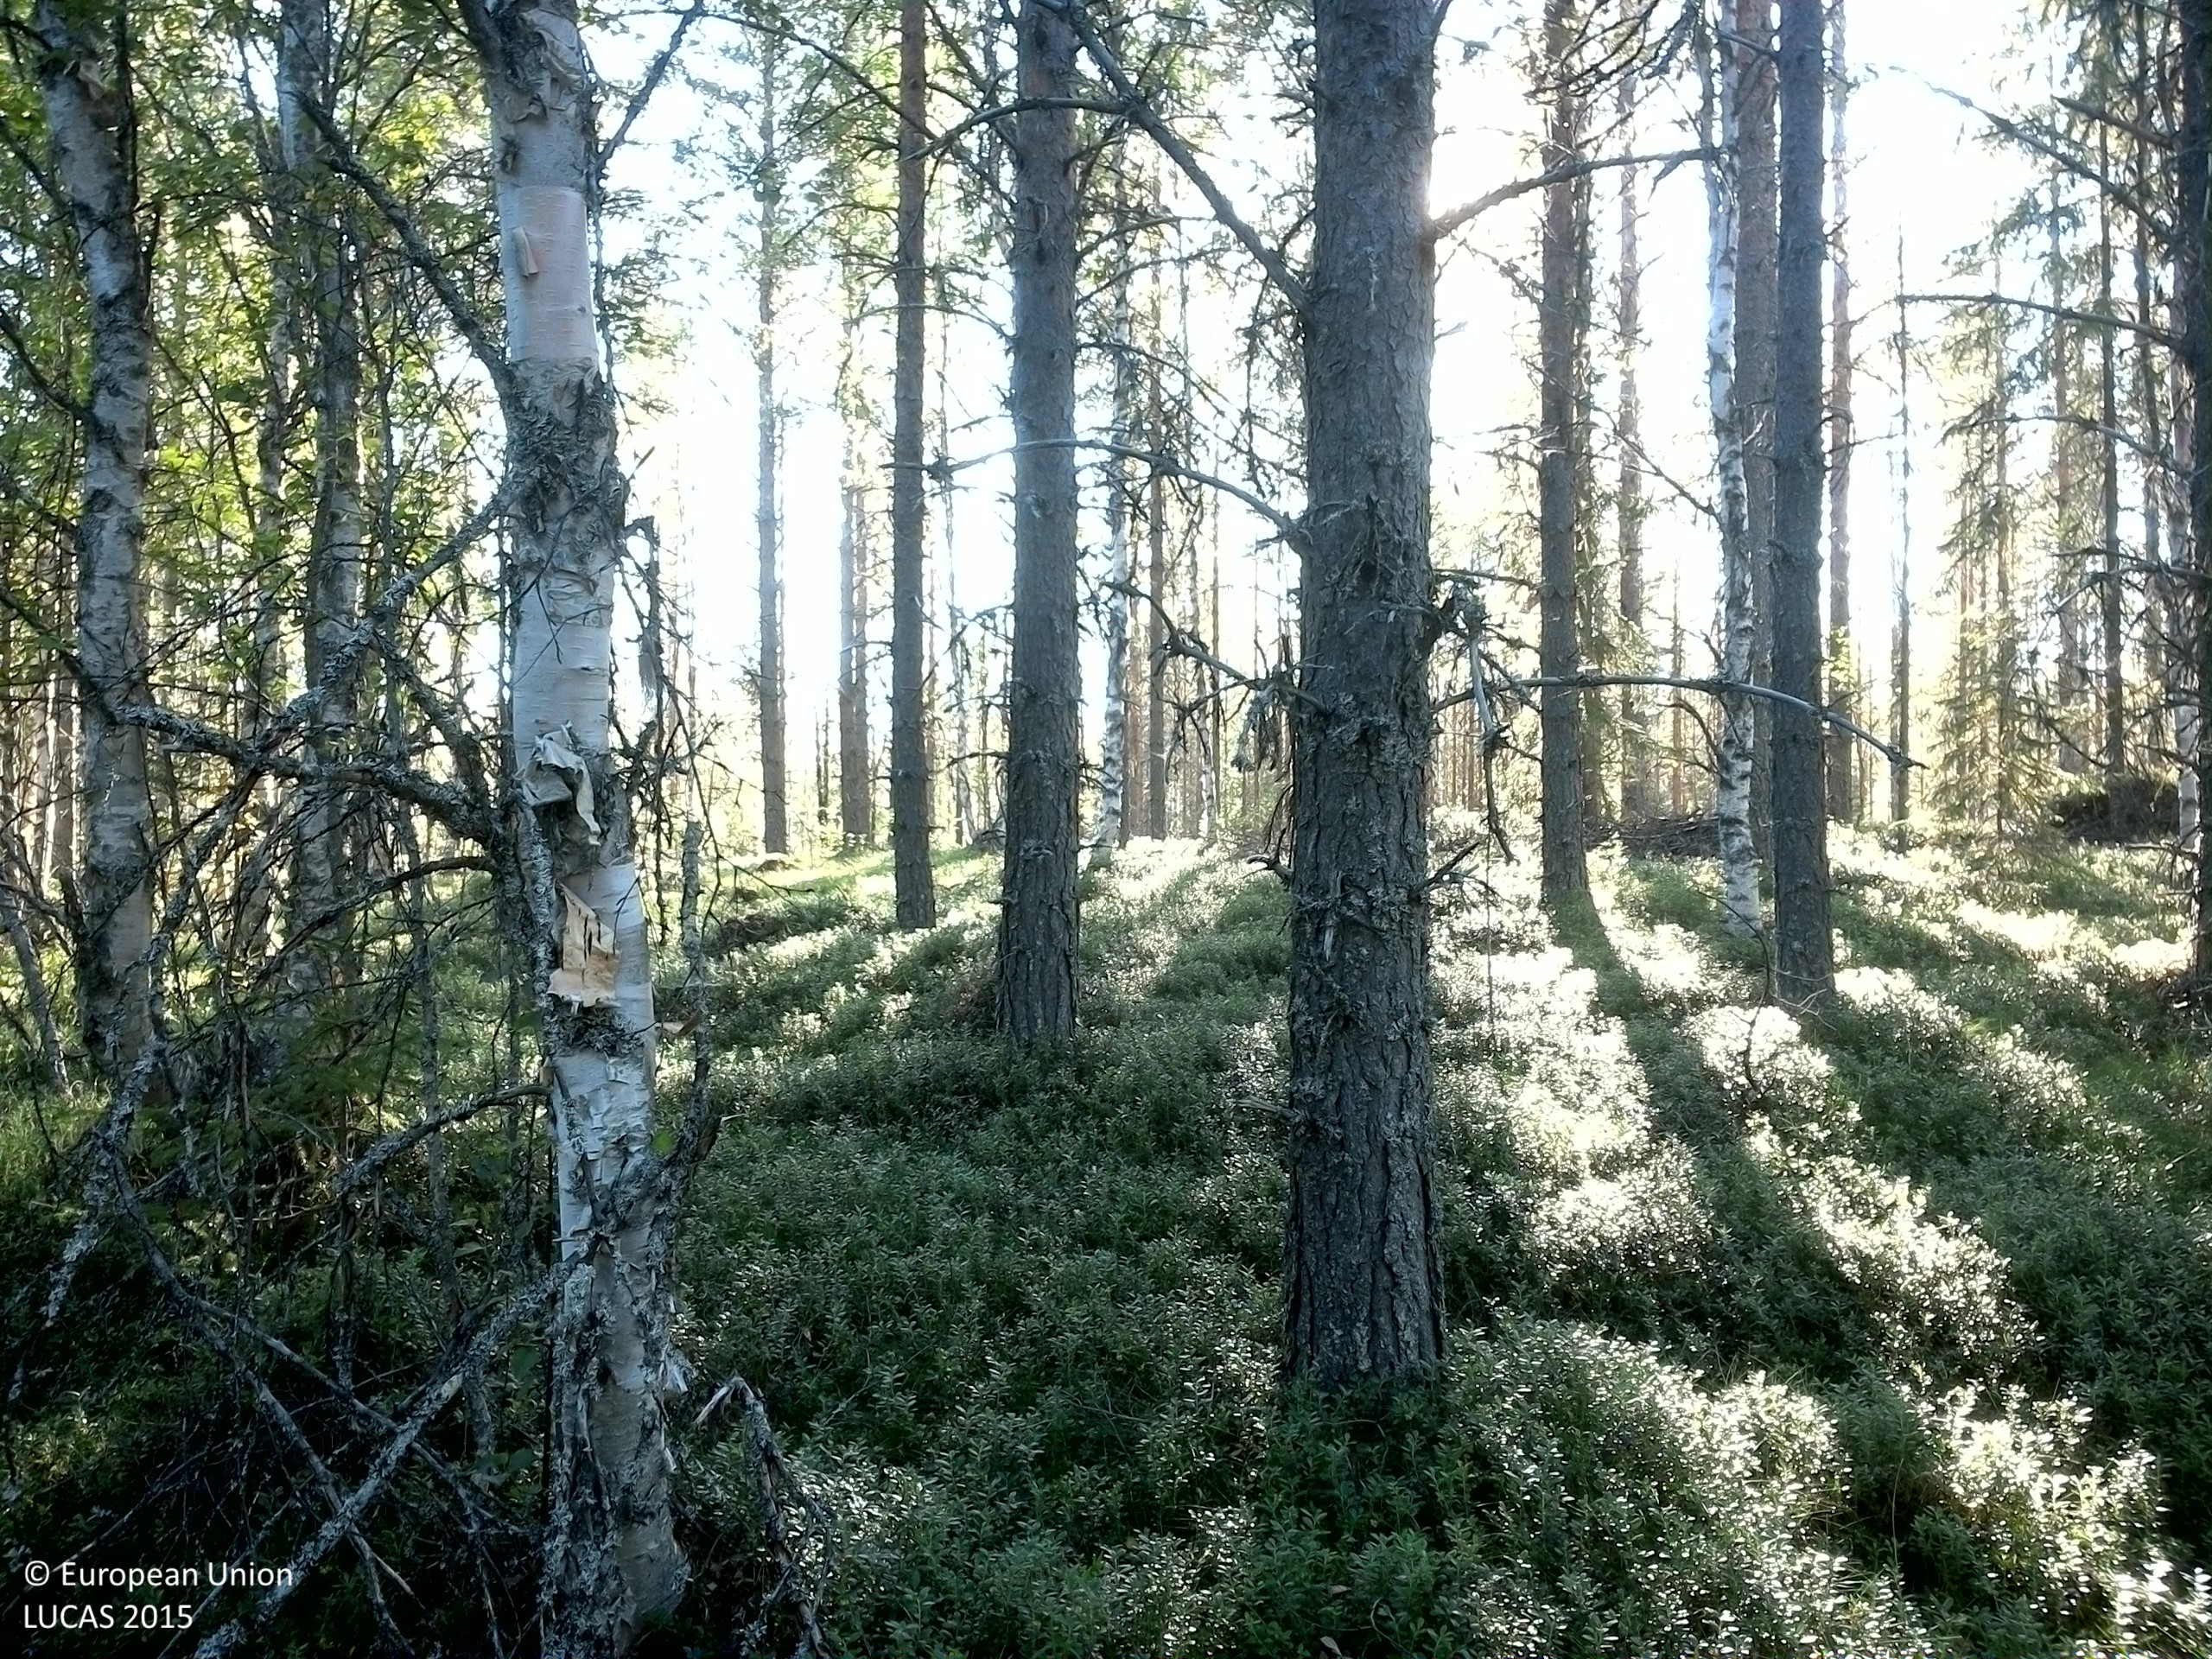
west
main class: Woodland
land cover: Pine dominated mixed woodland
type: boreal forest
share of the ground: > 75 %
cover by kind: coniferous forest trees 50 %, broadleaved forest trees 25 %, shrubs 20 %, herbaceous plants 5 %
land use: Forestry
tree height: > 5 m
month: August
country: SE
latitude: 63.9203
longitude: 17.3311
